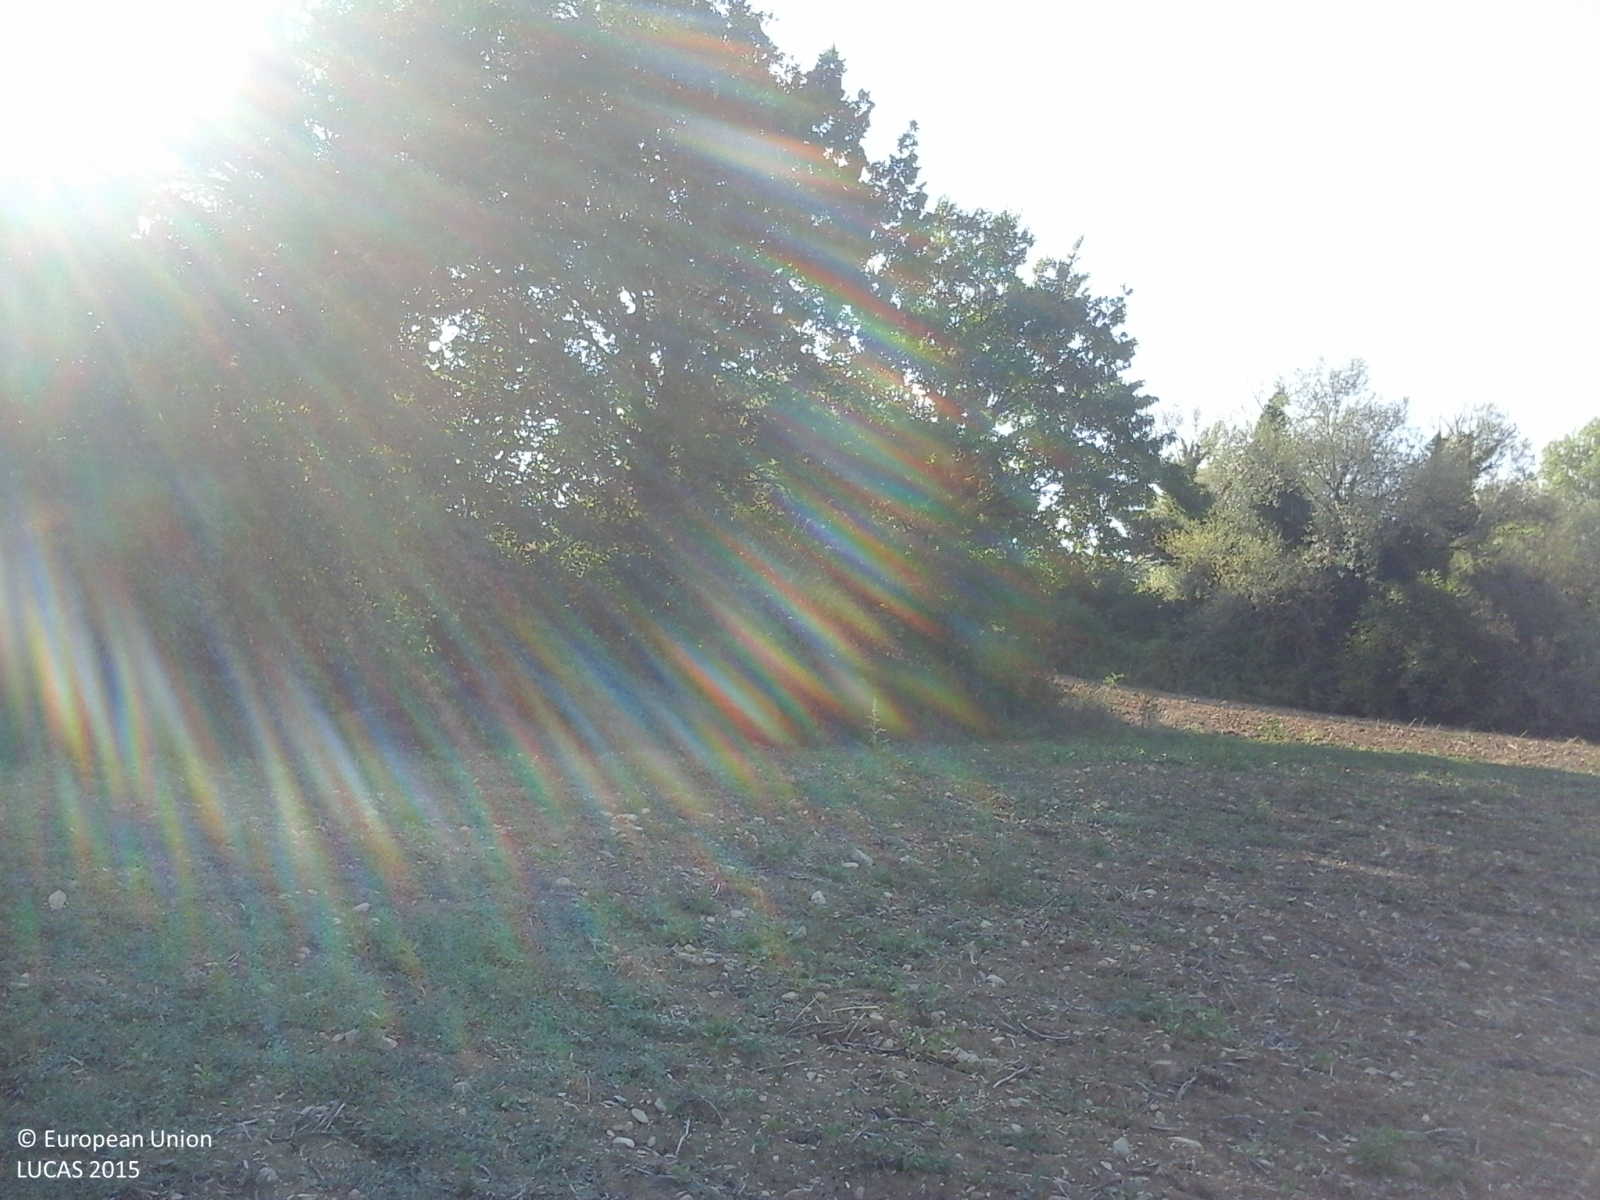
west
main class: Cropland
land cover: Dry pulses
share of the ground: < 10 %
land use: Agriculture (excluding fallow land and kitchen gardens)
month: August
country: IT
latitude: 42.8429
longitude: 12.3786
